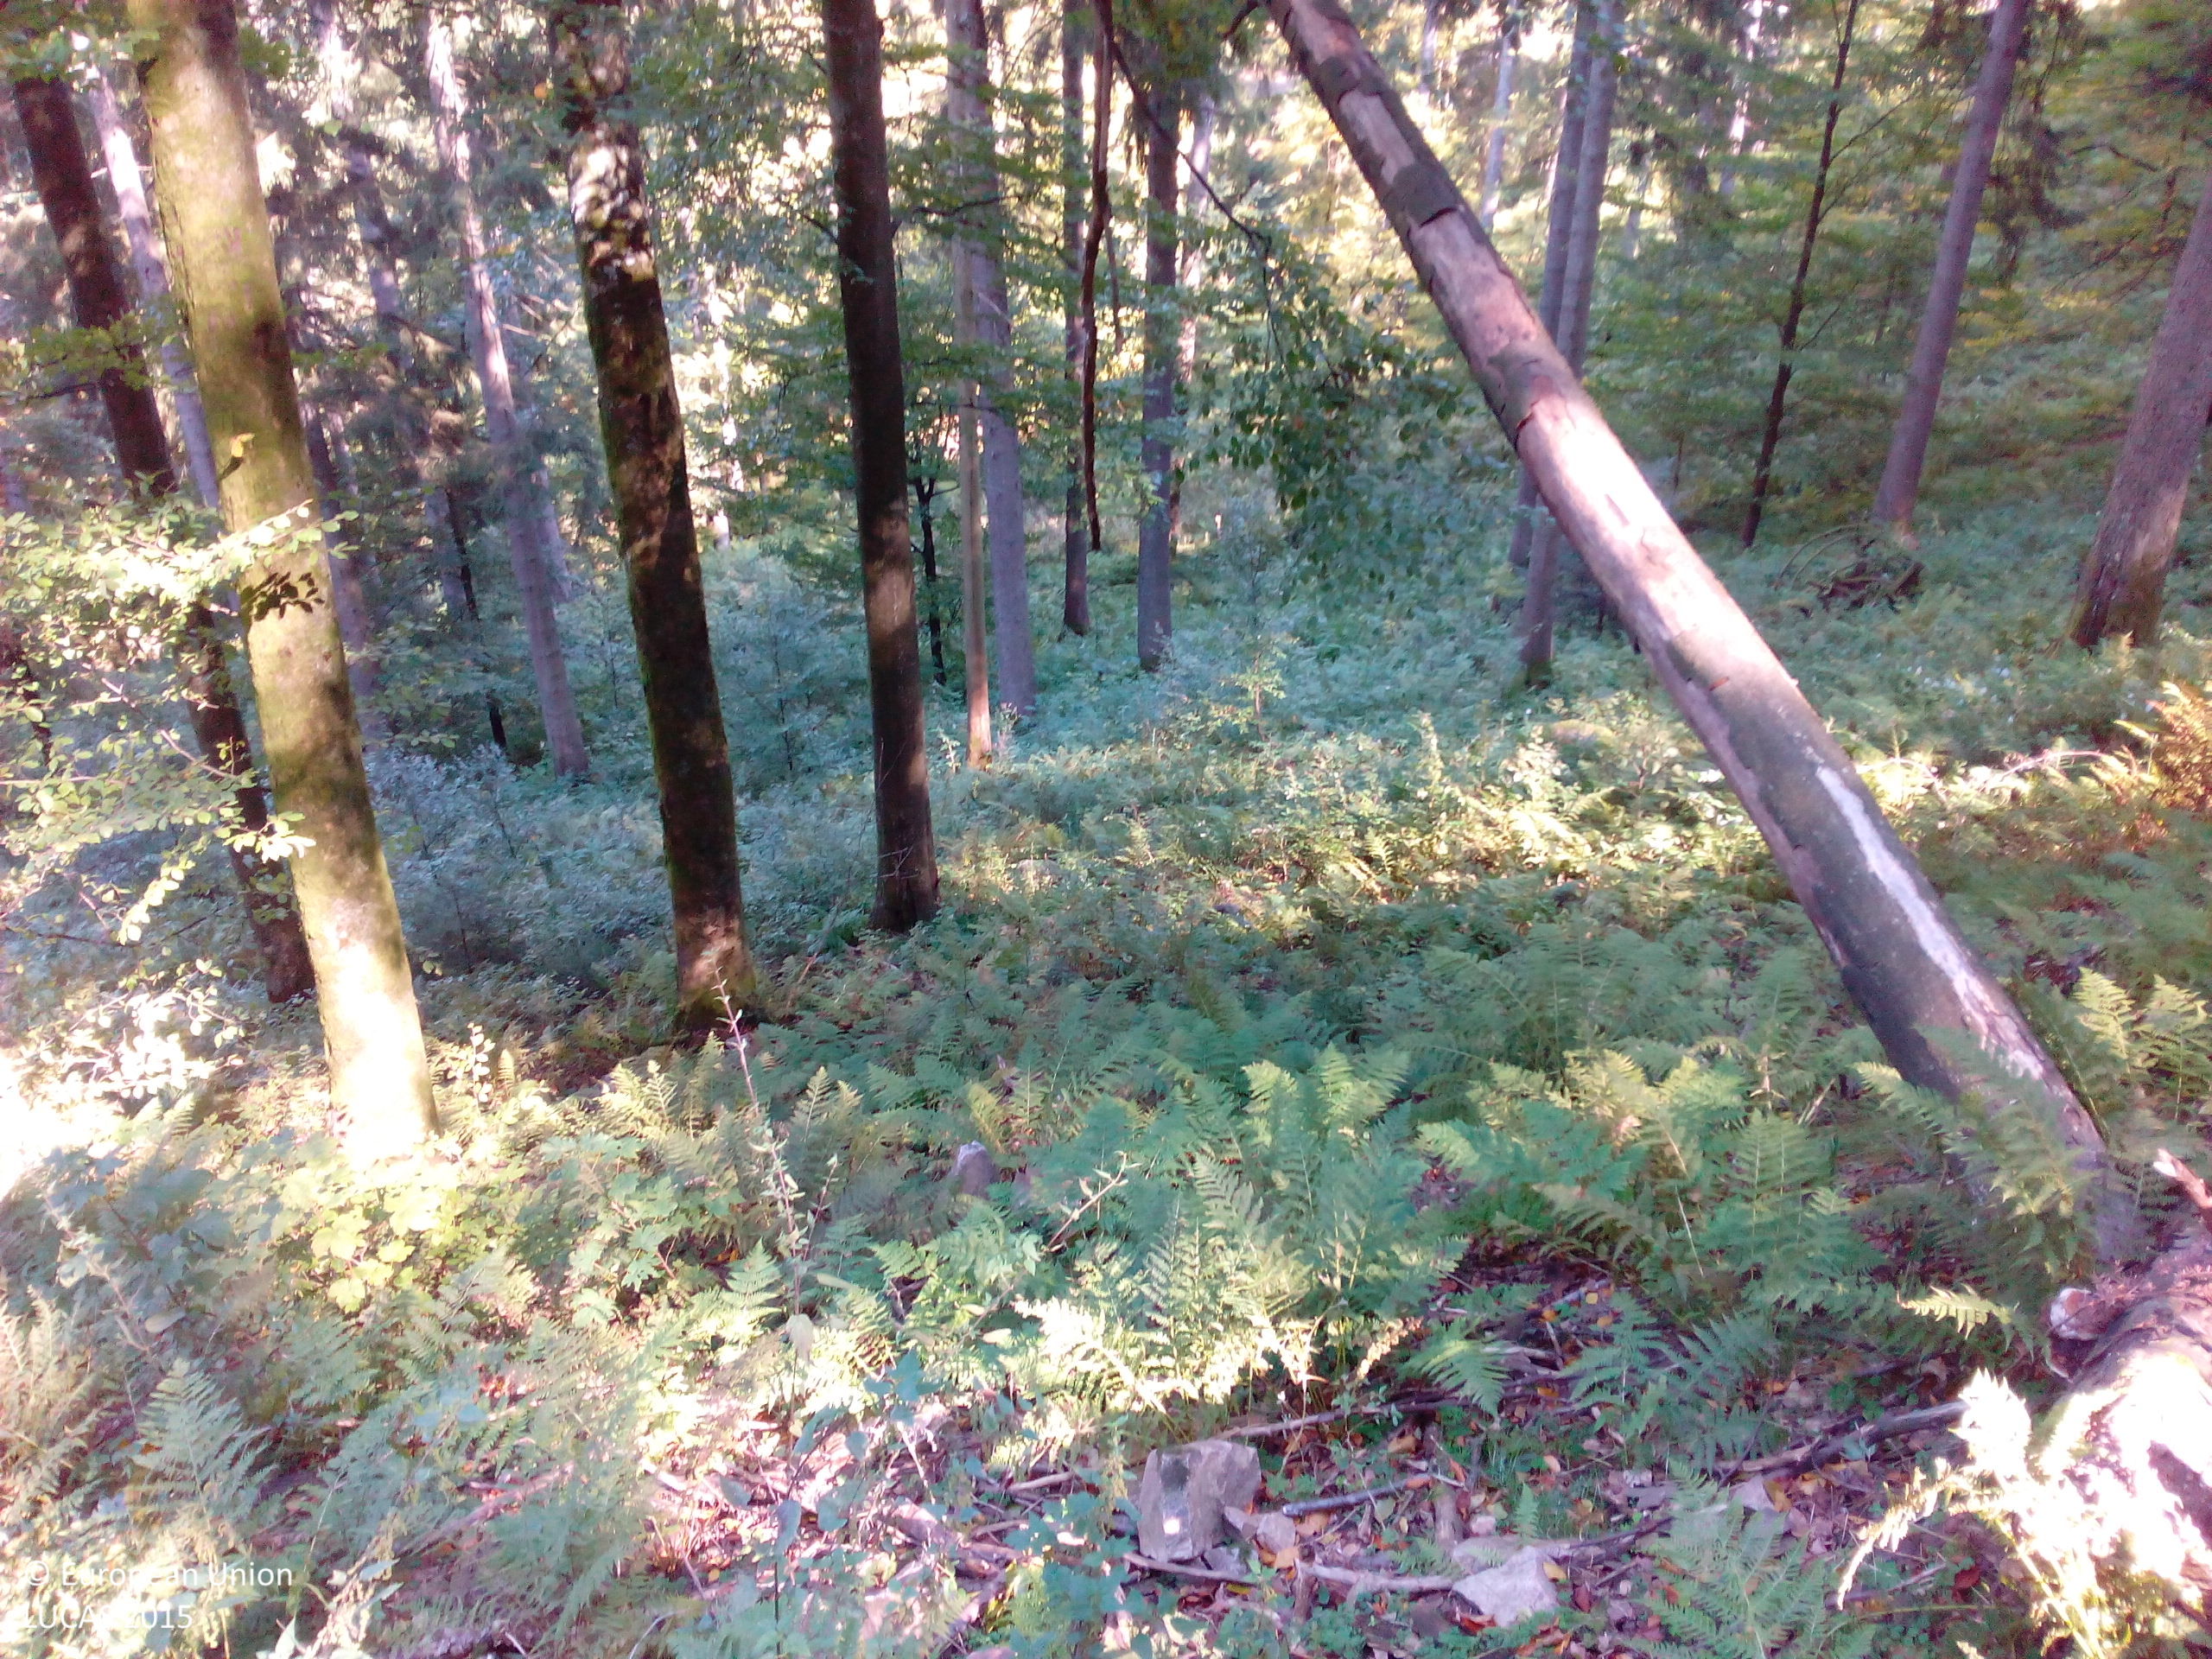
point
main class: Woodland
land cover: Other mixed woodland
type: hemiboreal forest and nemoral coniferous forest and mixed broadleaved-coniferous forest
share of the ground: 50 - 75 %
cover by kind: broadleaved forest trees 40 %, coniferous forest trees 30 %, shrubs 20 %, herbaceous plants 10 %
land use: Forestry
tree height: > 5 m
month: September
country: DE
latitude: 48.6228
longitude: 8.1964
